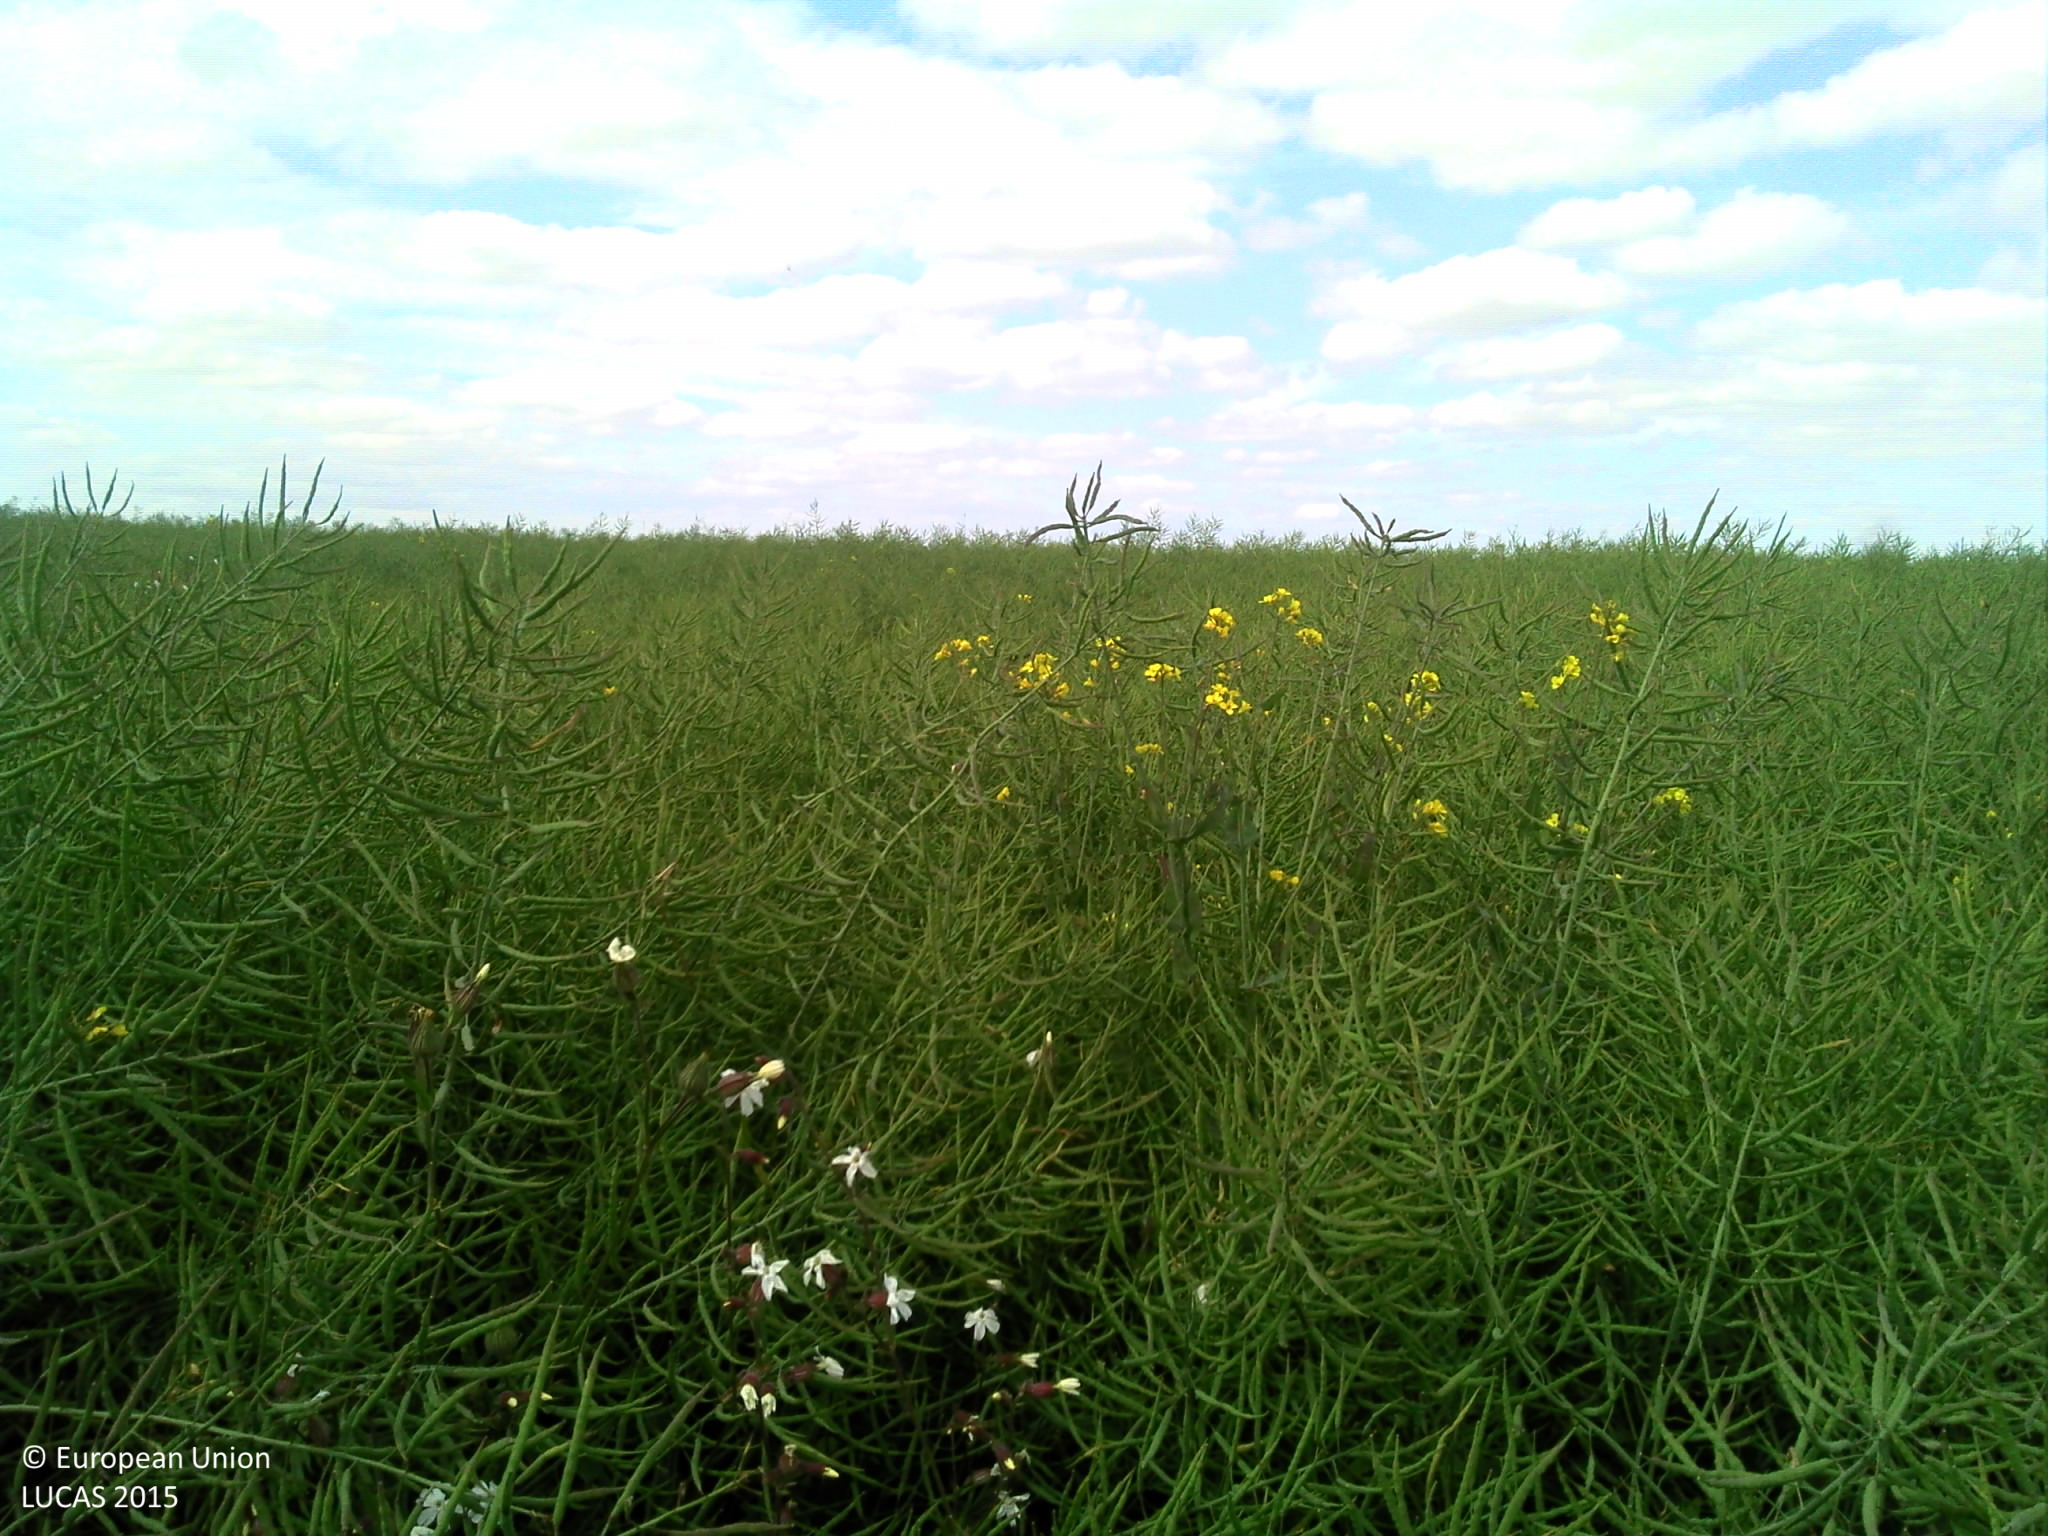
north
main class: Cropland
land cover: Rape and turnip rape
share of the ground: > 75 %
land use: Agriculture (excluding fallow land and kitchen gardens)
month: June
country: FR
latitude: 48.4308
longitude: 1.8903
